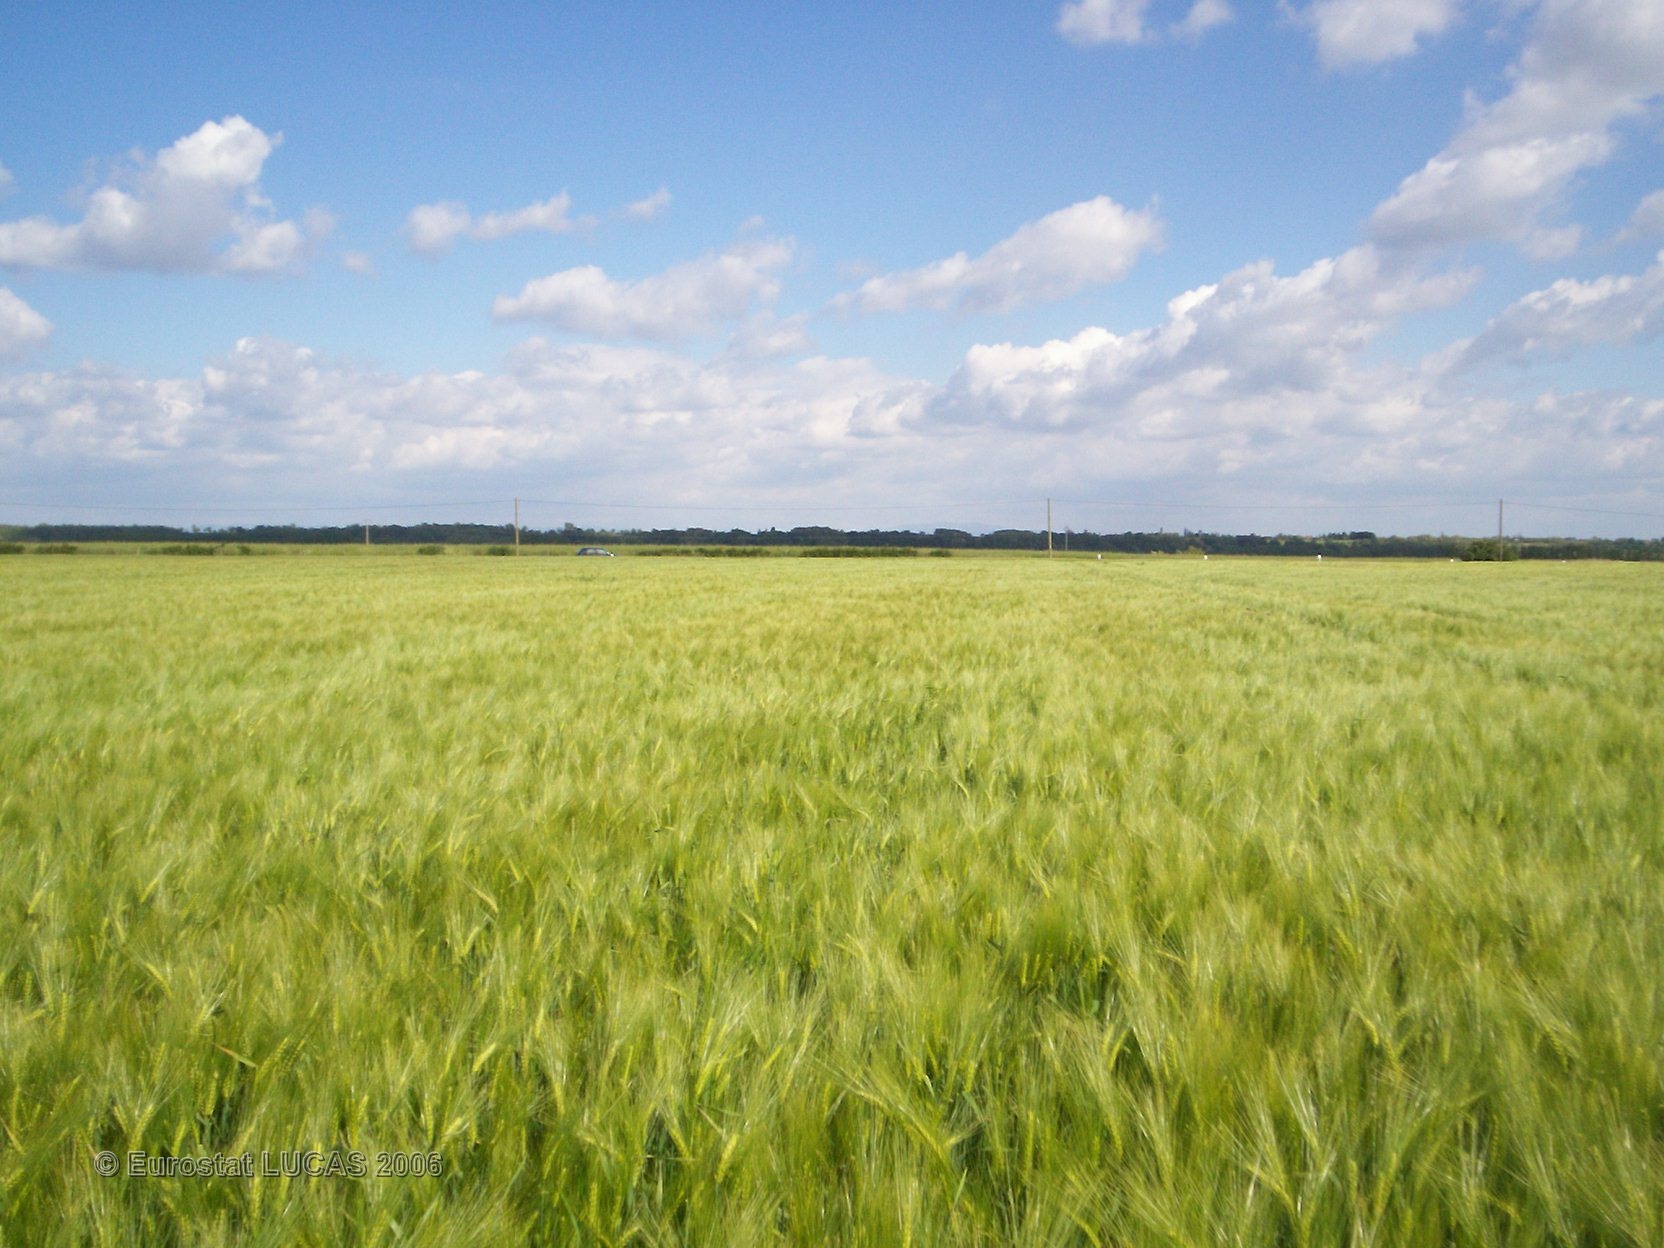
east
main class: Cropland
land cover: Barley
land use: Agriculture (excluding fallow land and kitchen gardens)
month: June
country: FR
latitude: 46.1904
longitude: 3.2224
